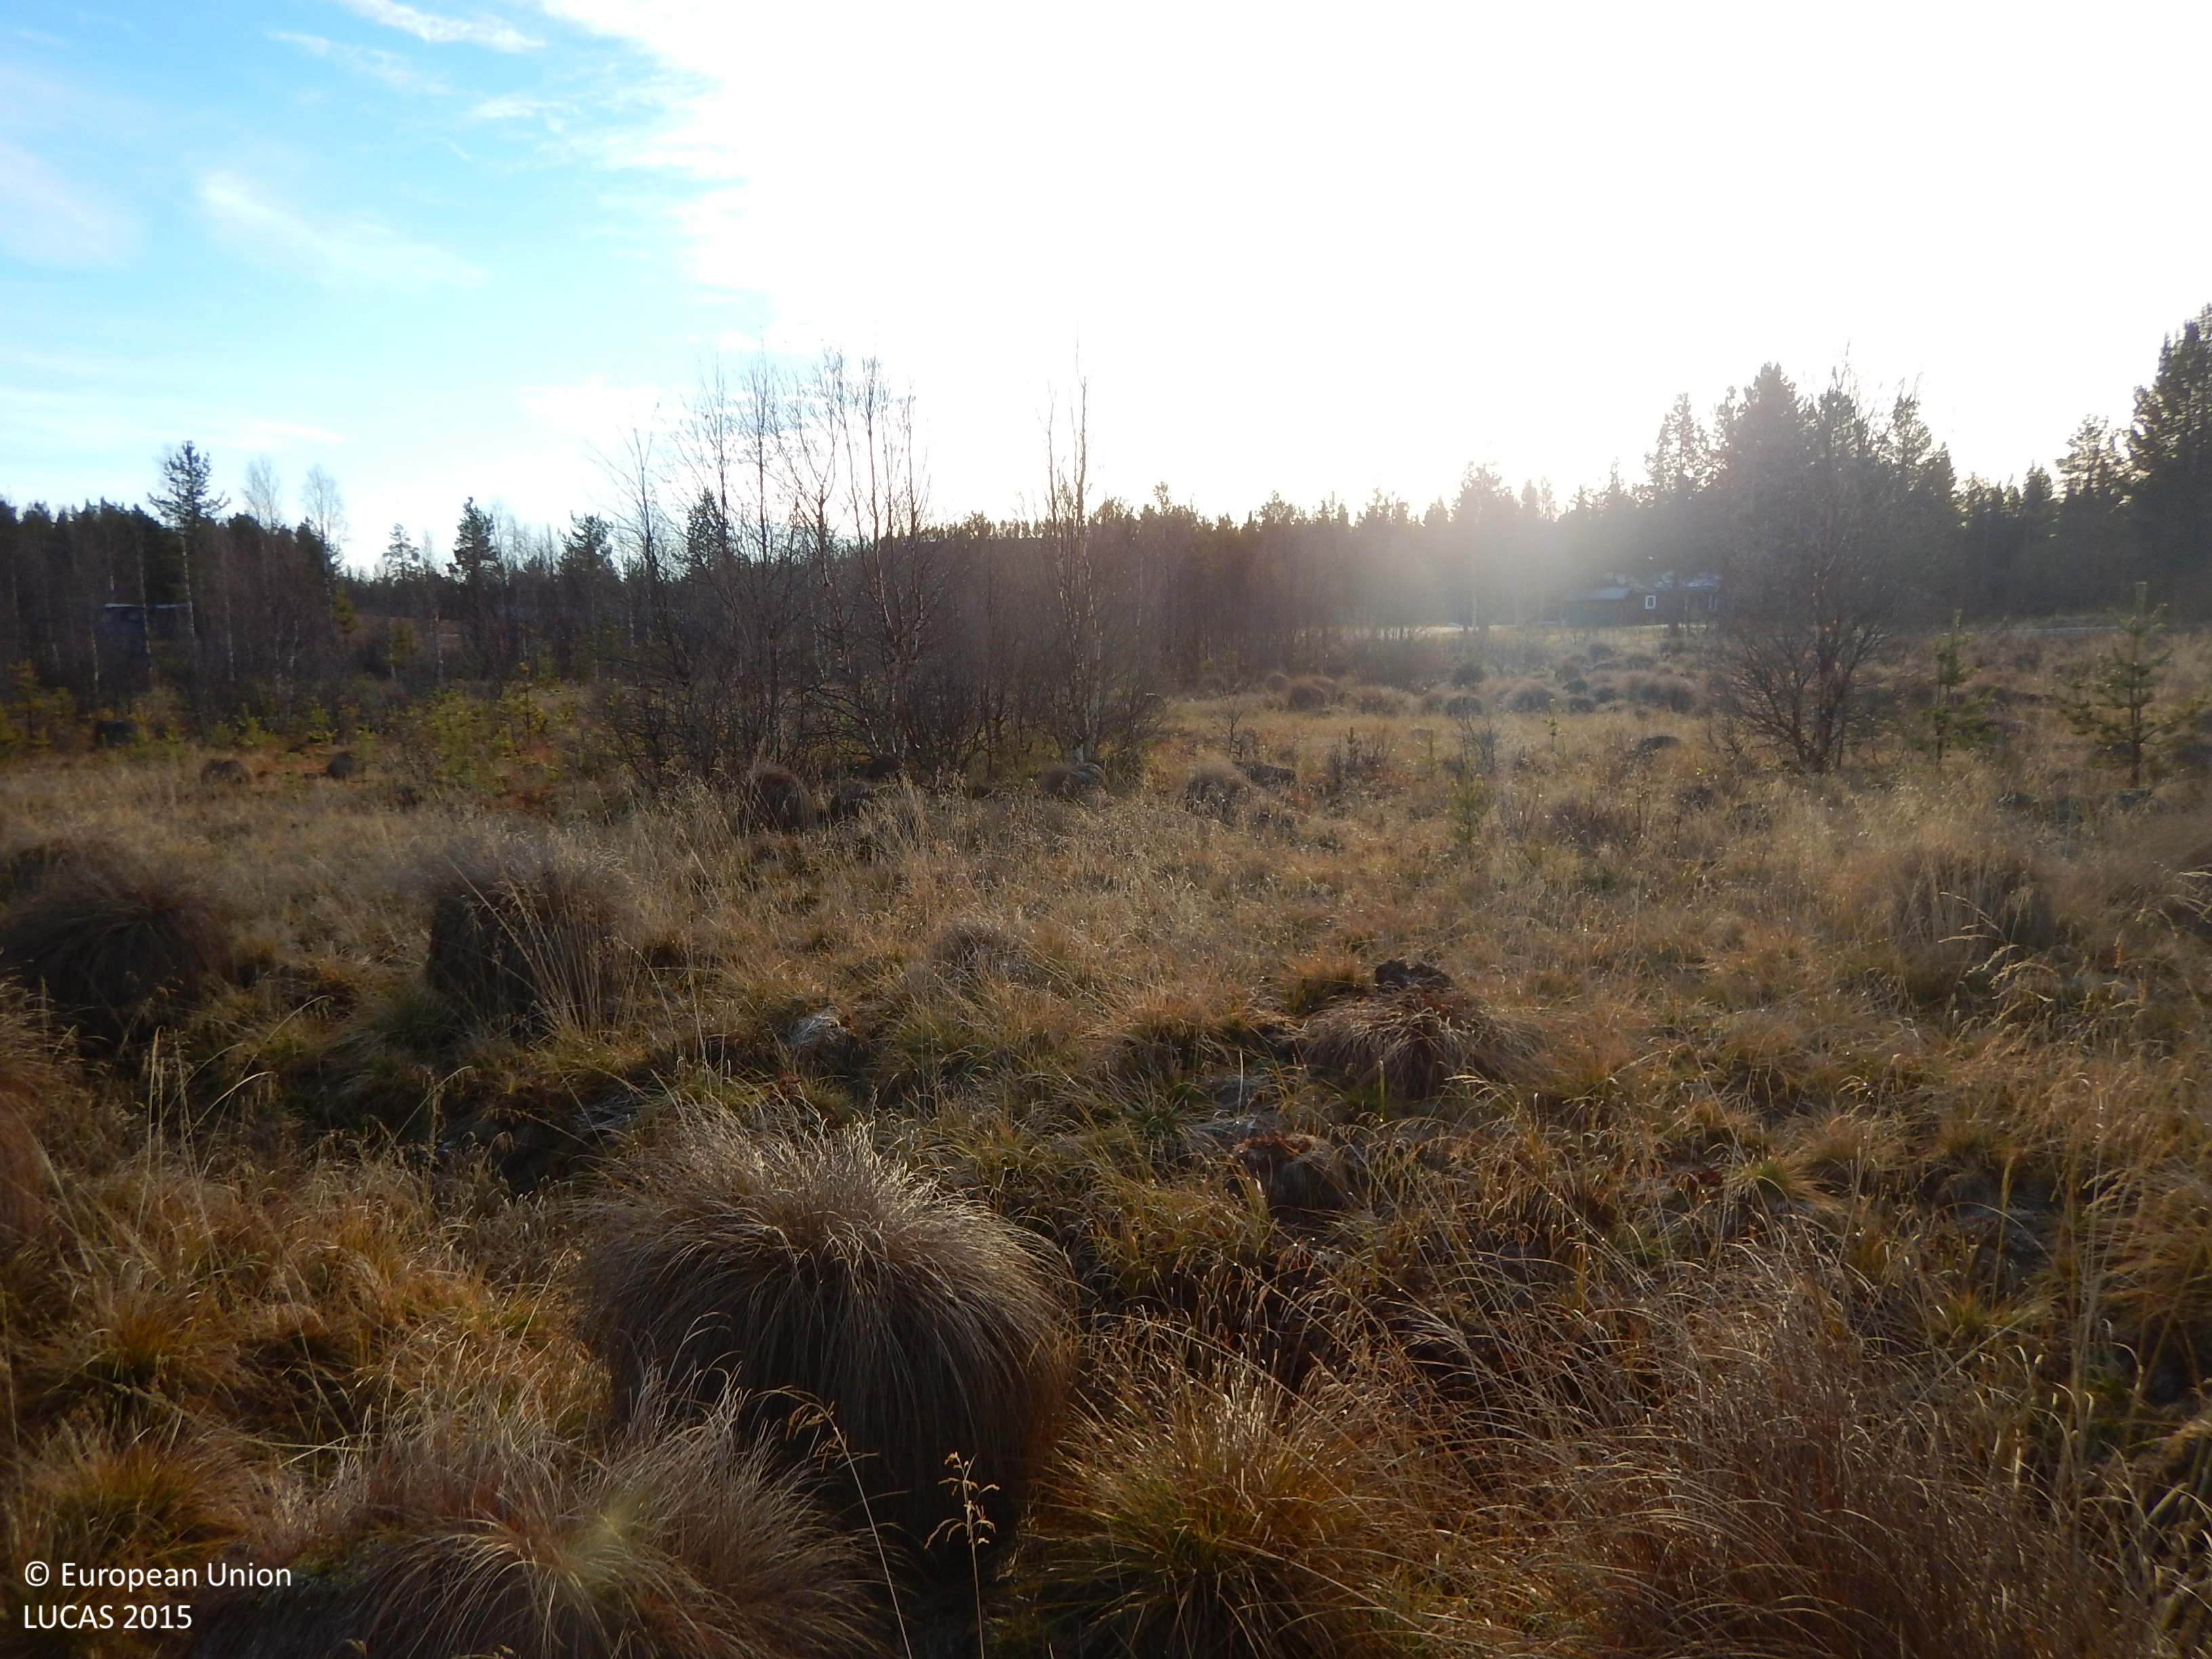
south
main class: Grassland
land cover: Grassland without tree/shrub cover
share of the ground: > 75 %
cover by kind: herbaceous plants 80 %, lichens and mosses 20 %
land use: Abandoned areas
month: October
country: SE
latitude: 65.3353
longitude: 20.0817
